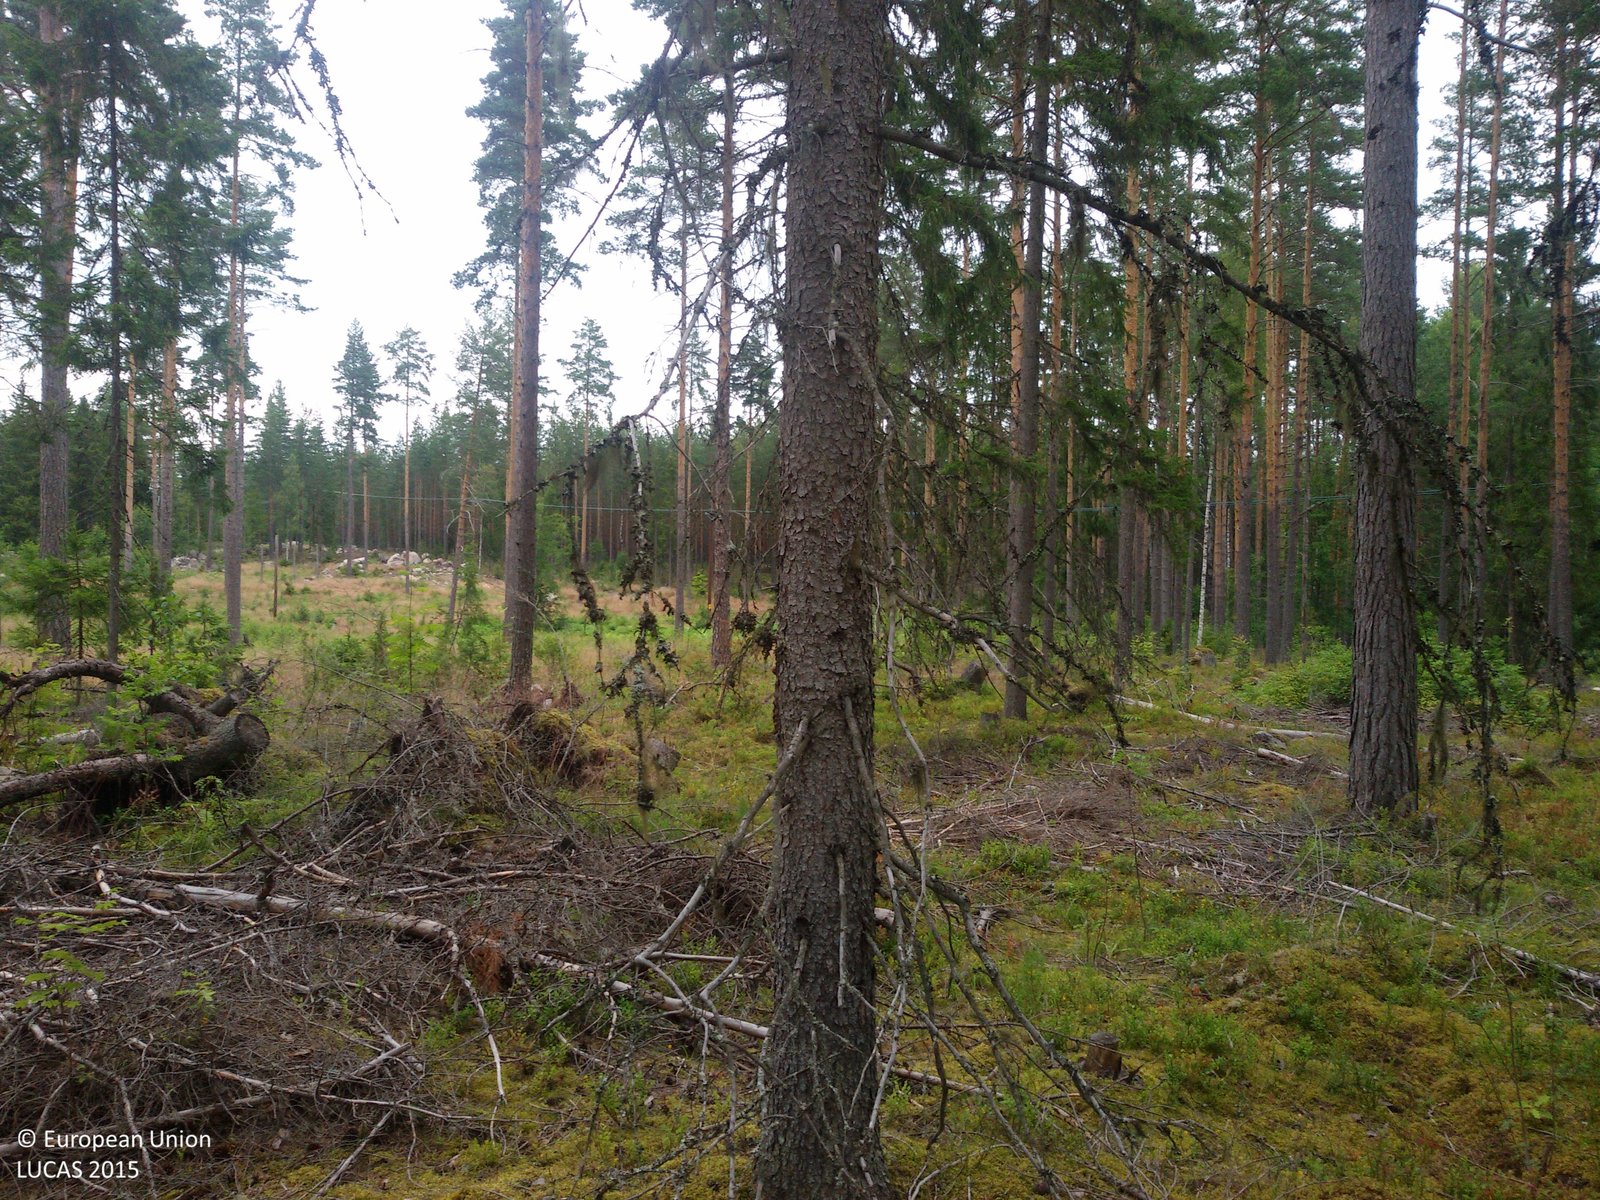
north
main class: Woodland
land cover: Pine dominated coniferous woodland
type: boreal forest
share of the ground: 50 - 75 %
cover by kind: coniferous forest trees 60 %, lichens and mosses 30 %, shrubs 10 %
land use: Forestry
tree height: > 5 m
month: August
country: SE
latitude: 60.6950
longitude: 16.5998
